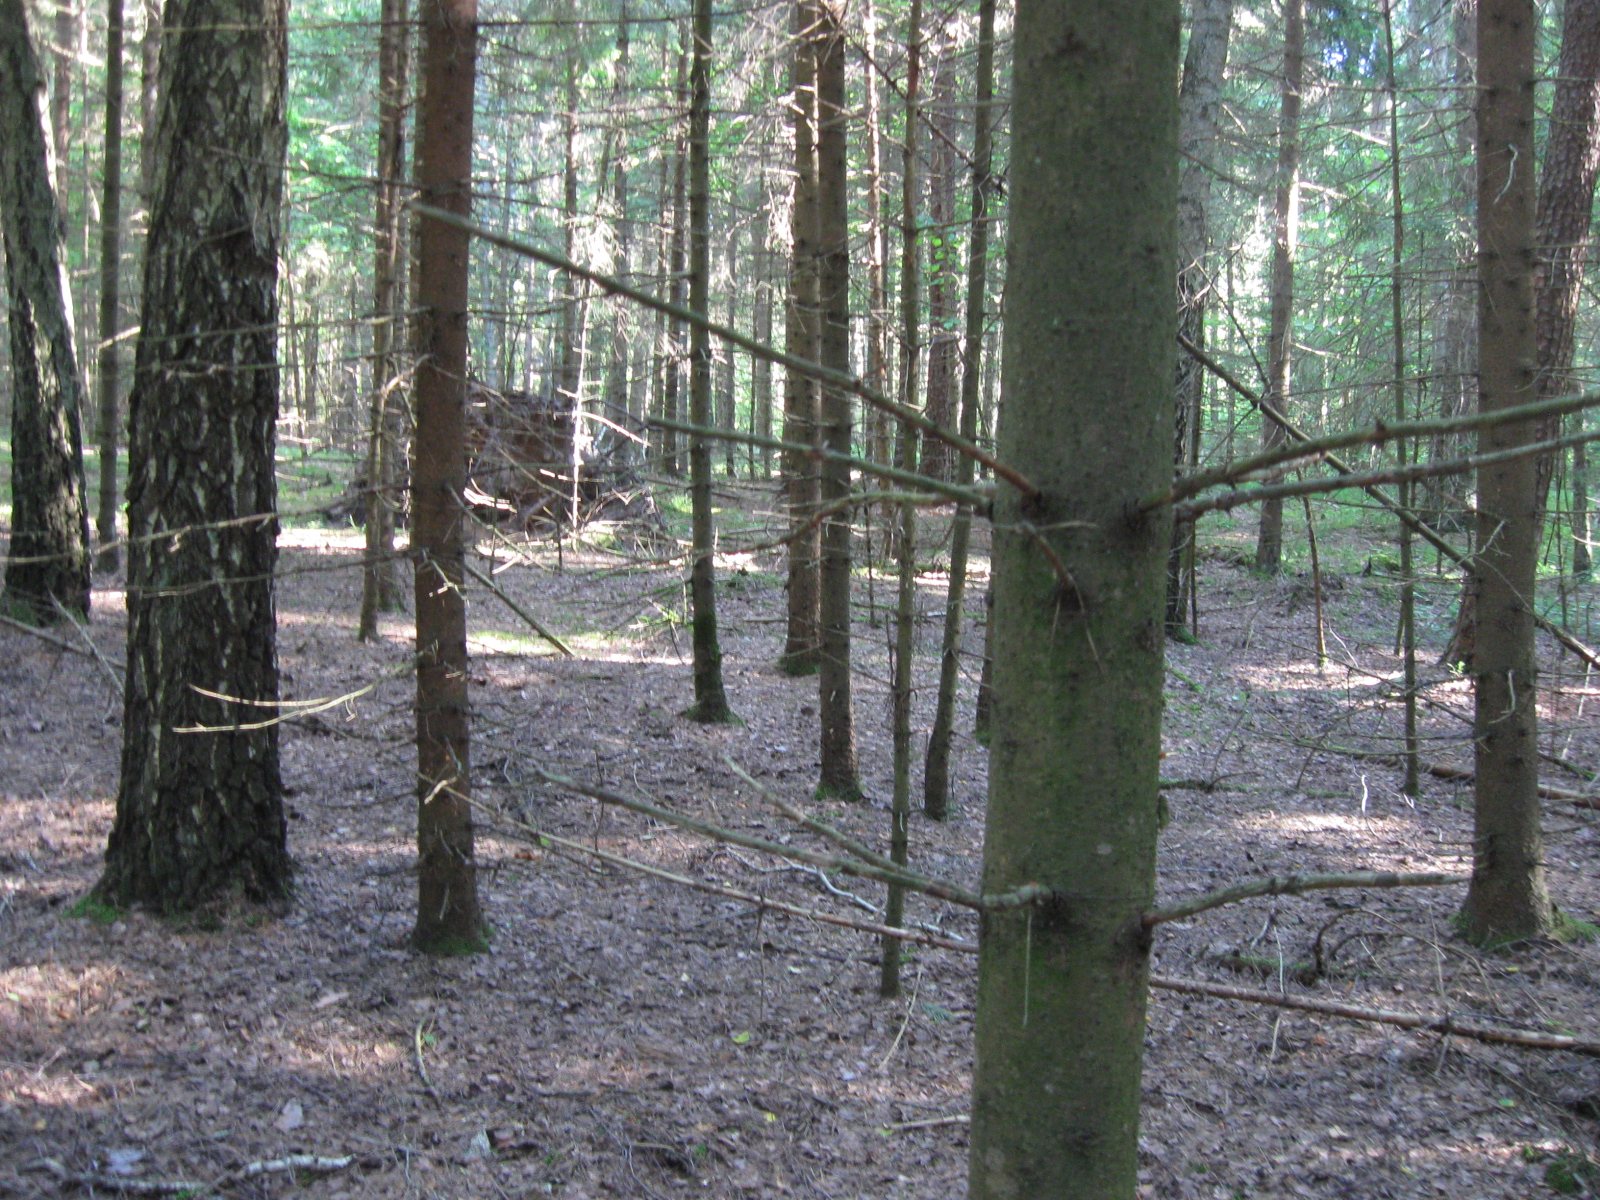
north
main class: Woodland
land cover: Spruce dominated coniferous woodland
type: hemiboreal forest and nemoral coniferous forest and mixed broadleaved-coniferous forest
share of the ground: > 75 %
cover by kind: coniferous forest trees 95 %, broadleaved forest trees 5 %
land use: Forestry
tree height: > 5 m
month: June
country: LT
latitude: 54.0711
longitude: 24.7026
